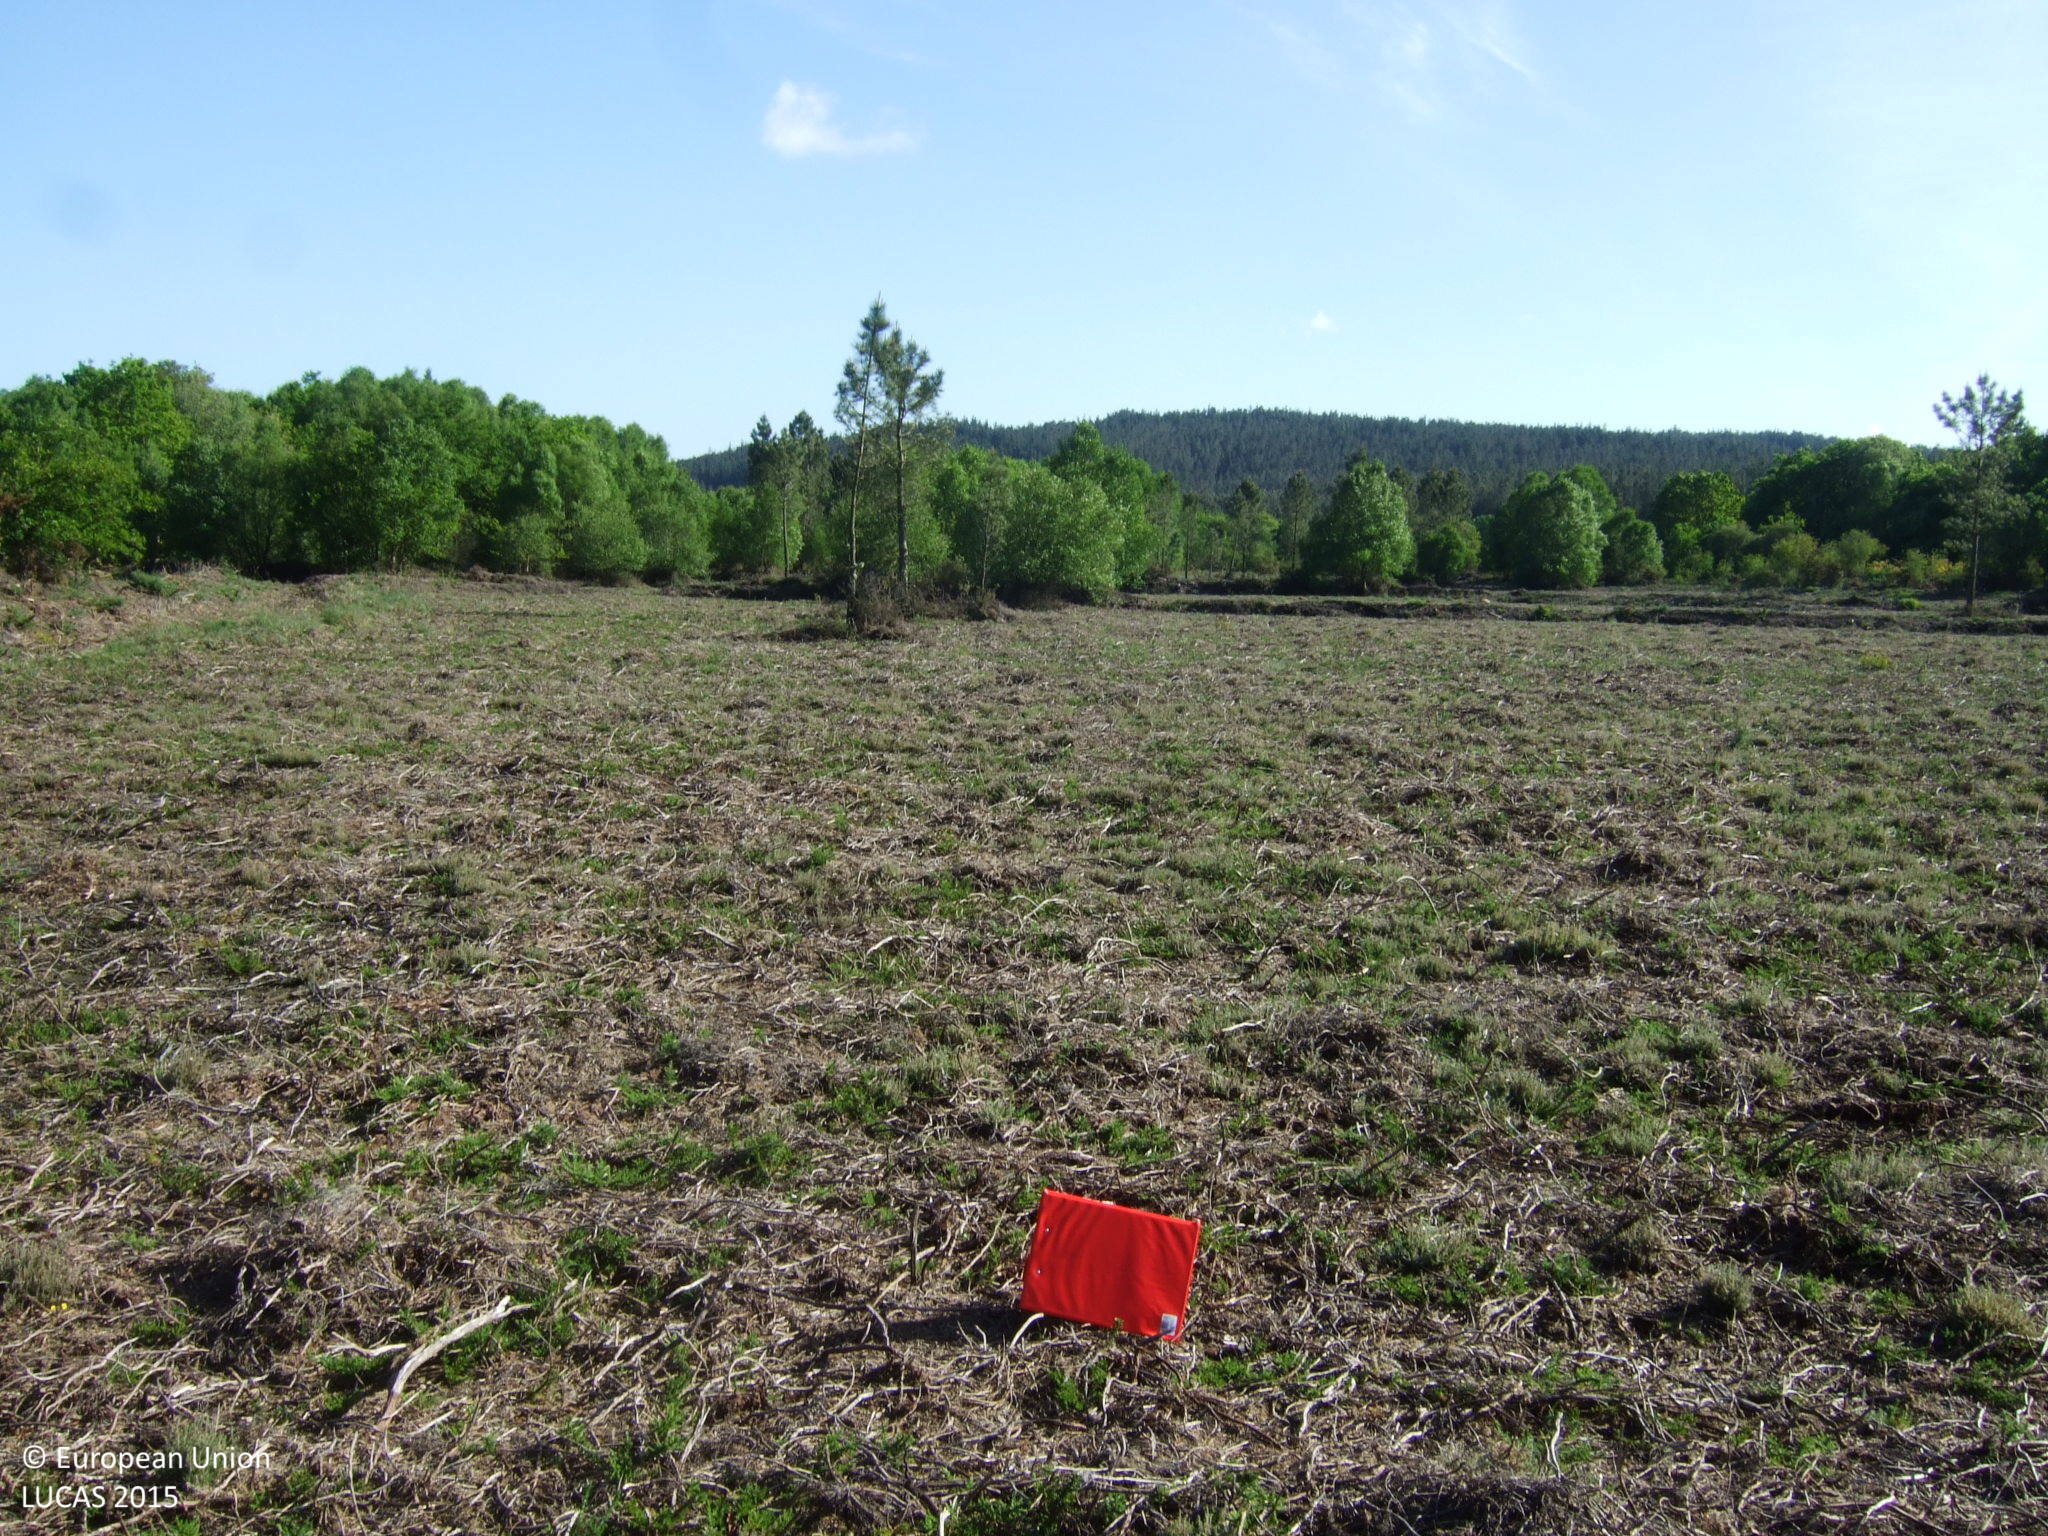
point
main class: Shrubland
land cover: Shrubland without tree cover
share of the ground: > 75 %
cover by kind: unconsolidated bare surface 90 %, shrubs 10 %
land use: Abandoned areas
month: May
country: ES
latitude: 43.2062
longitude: -7.6710
